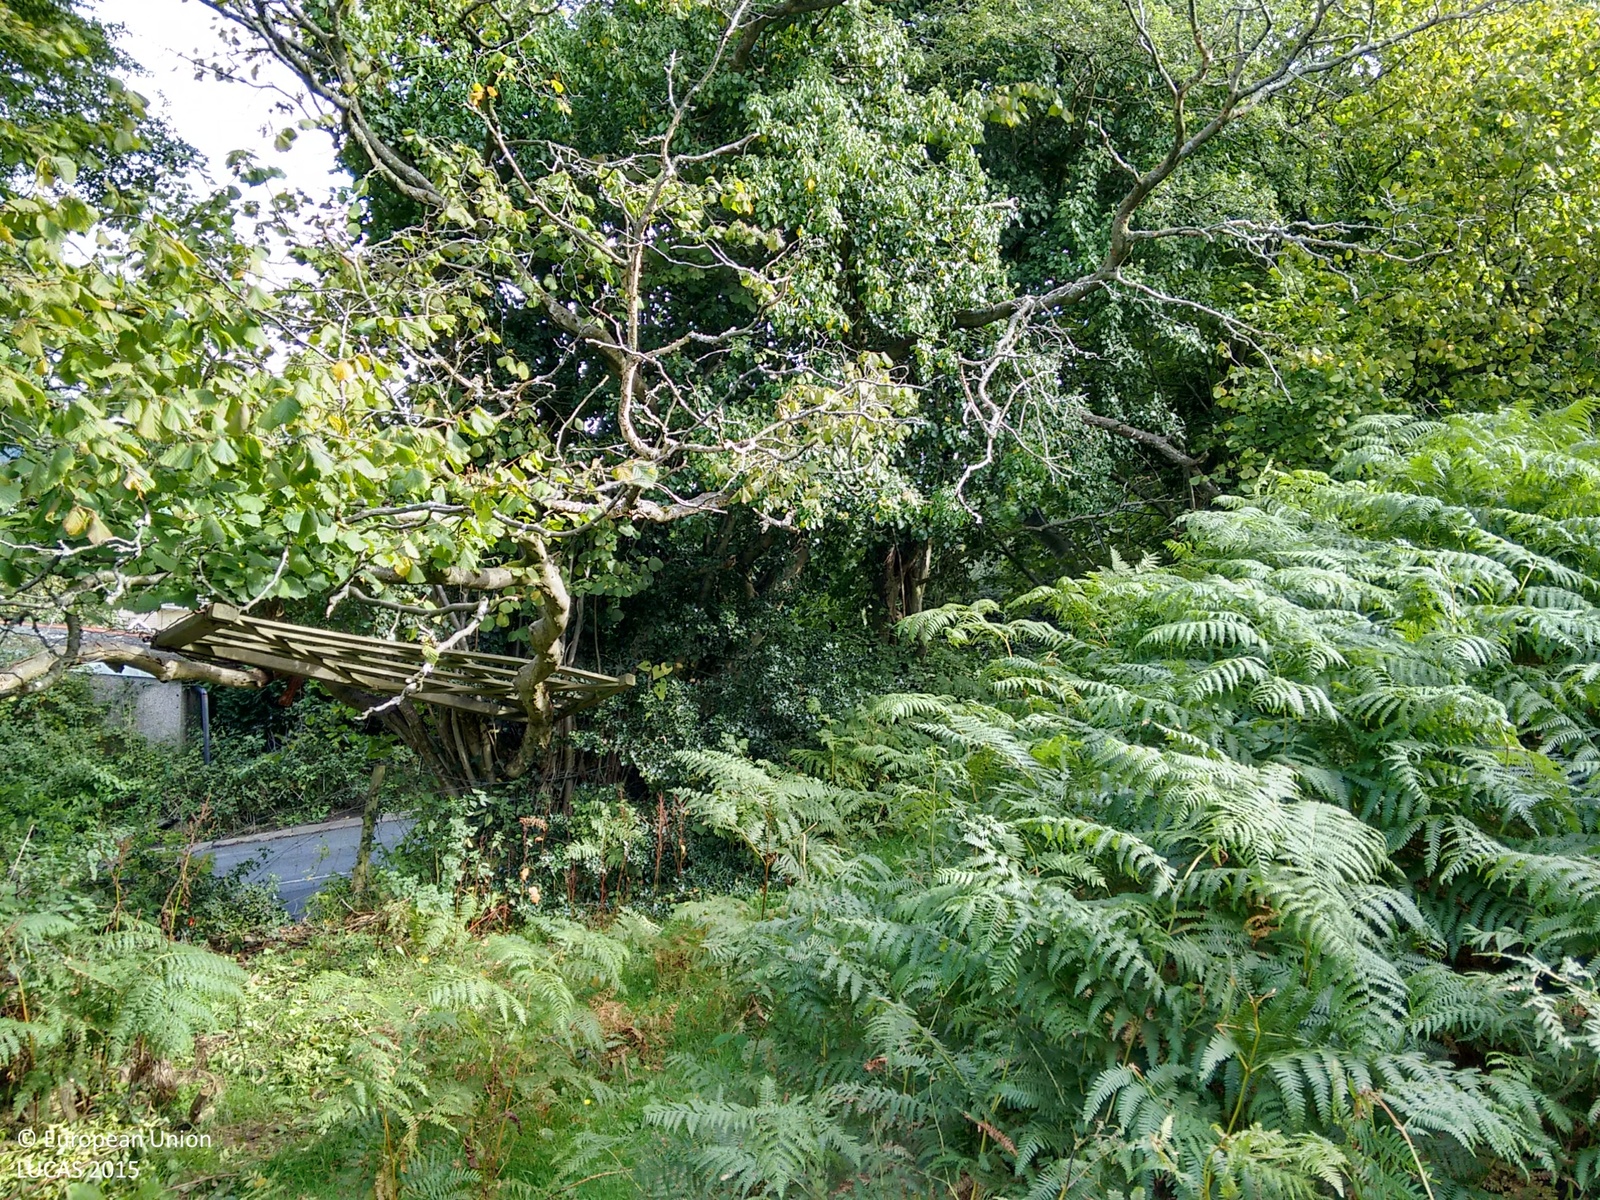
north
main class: Grassland
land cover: Grassland with sparse tree/shrub cover
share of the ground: > 75 %
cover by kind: herbaceous plants 95 %, broadleaved forest trees 5 %
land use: Semi-natural and natural areas not in use
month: September
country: GB
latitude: 51.8160
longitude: -3.0593
